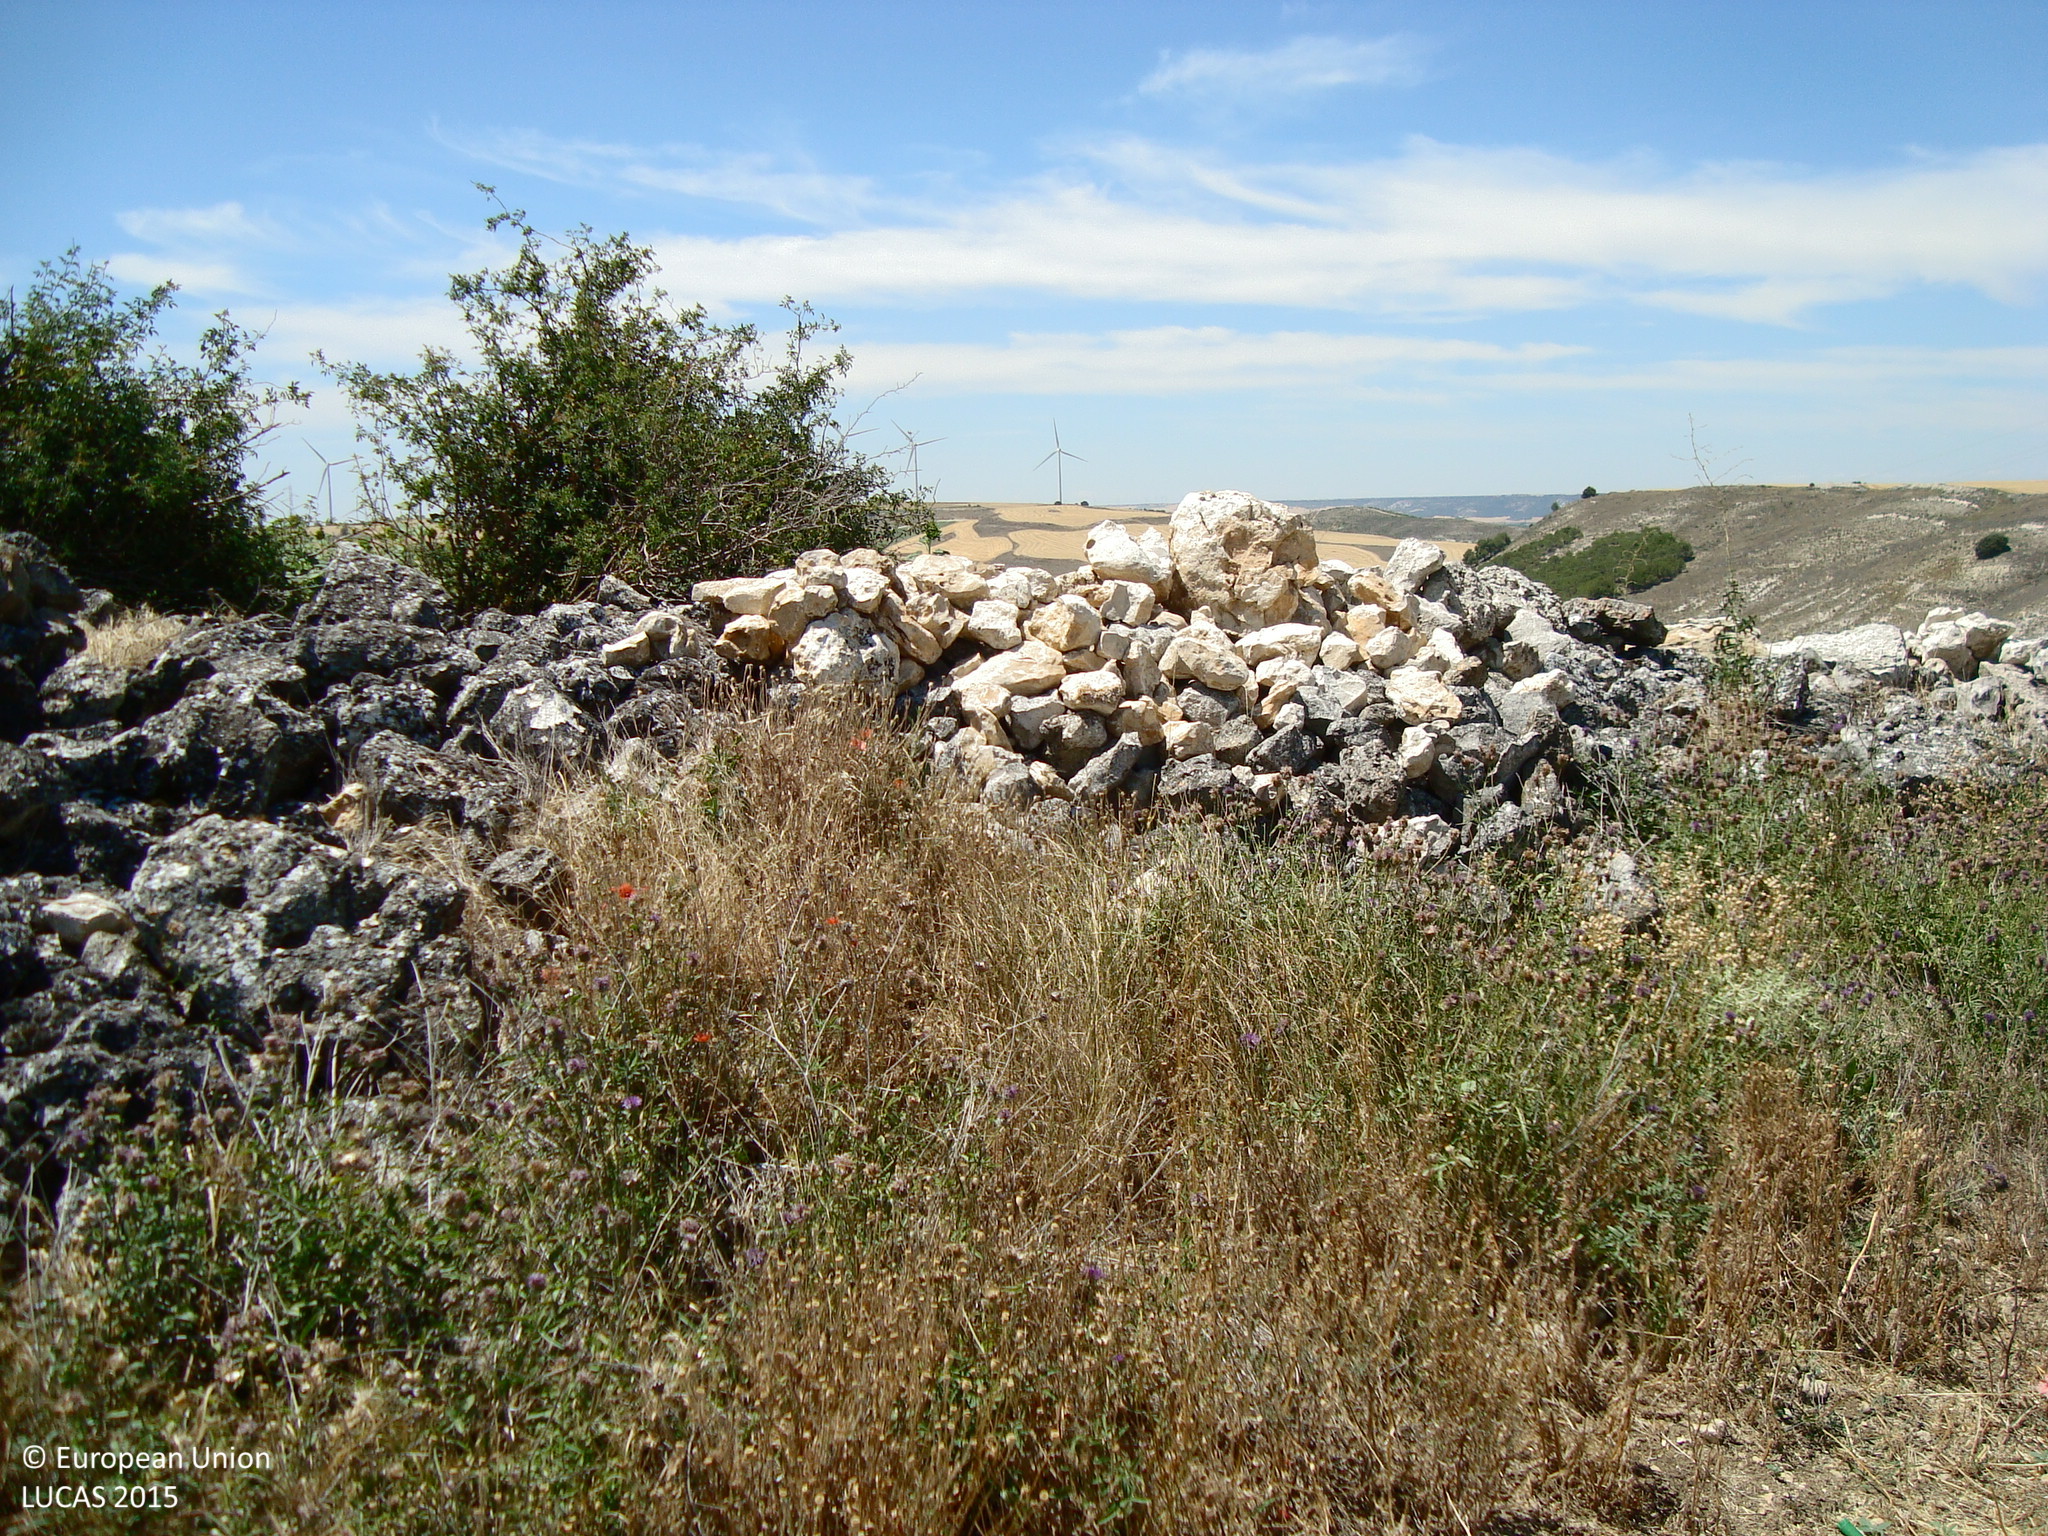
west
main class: Cropland
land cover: Barley
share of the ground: > 75 %
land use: Agriculture (excluding fallow land and kitchen gardens)
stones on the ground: 25 - 50 %
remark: Harvested field
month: July
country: ES
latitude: 42.0378
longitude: -4.1616
